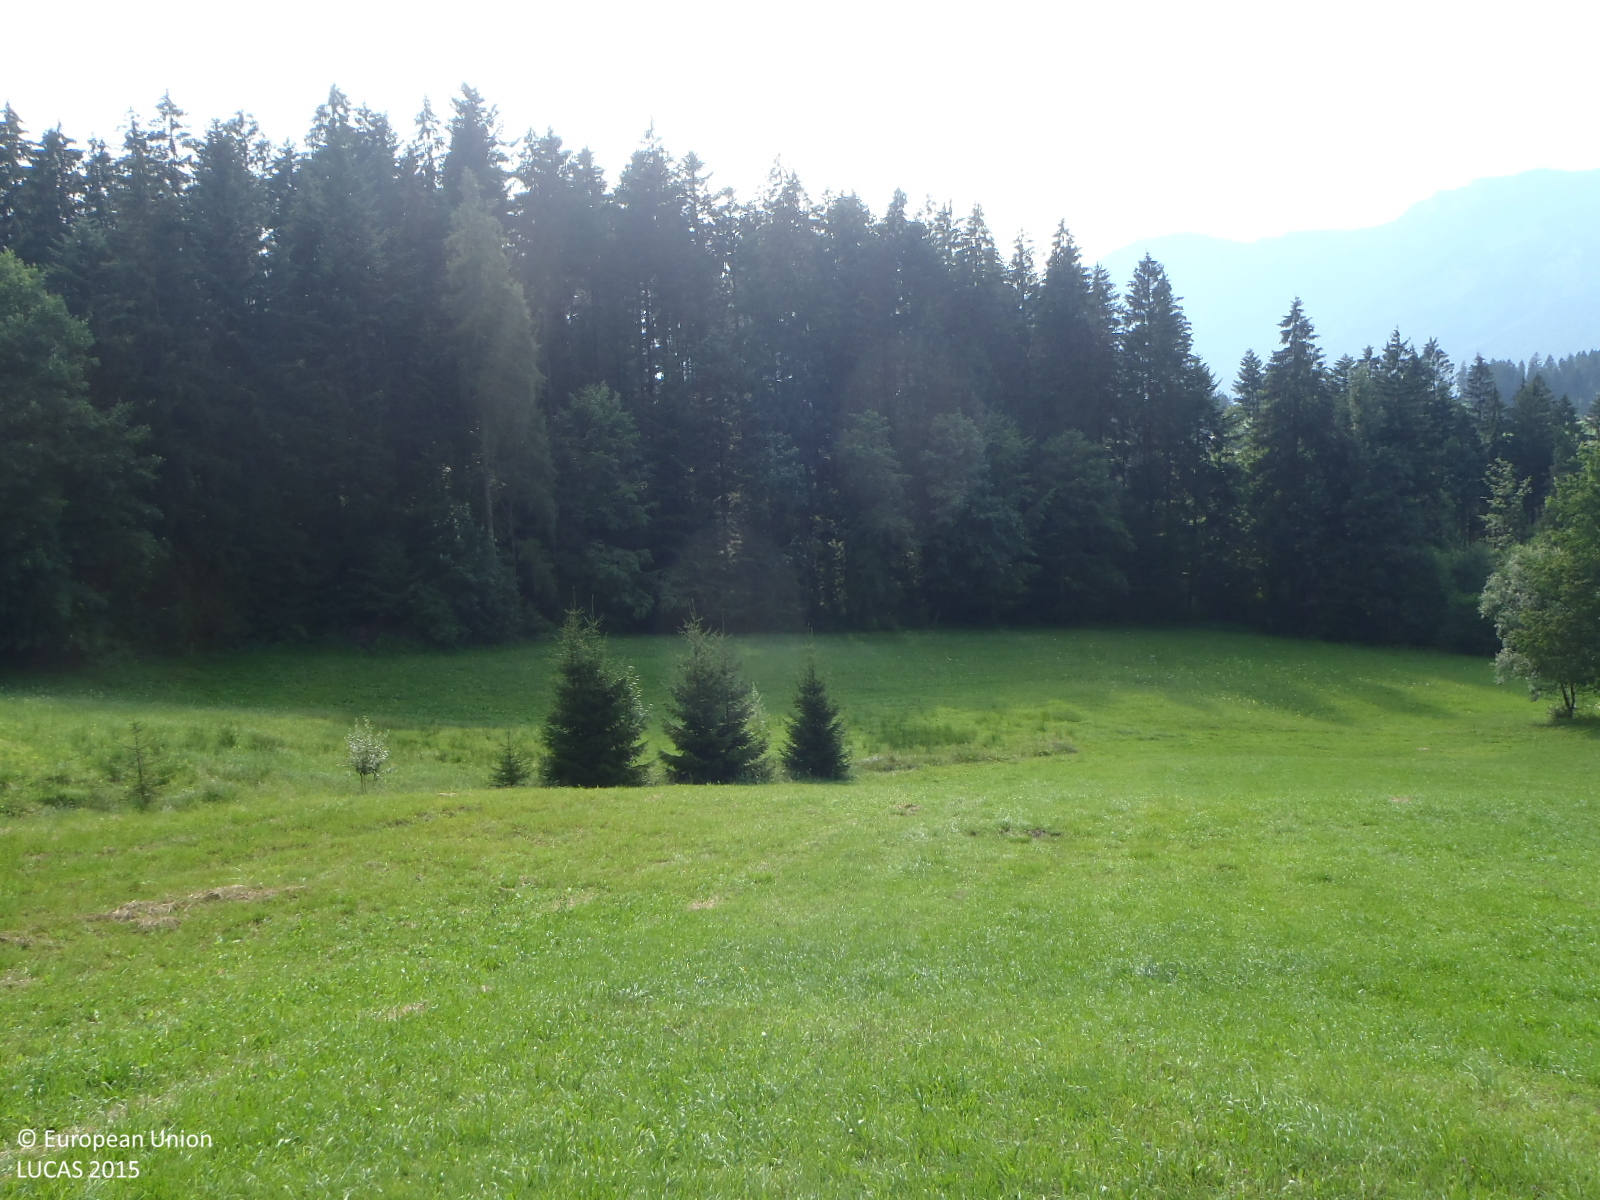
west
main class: Grassland
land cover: Grassland without tree/shrub cover
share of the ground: > 75 %
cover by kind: herbaceous plants 100 %
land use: Agriculture (excluding fallow land and kitchen gardens)
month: July
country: AT
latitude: 47.5187
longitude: 12.1365
